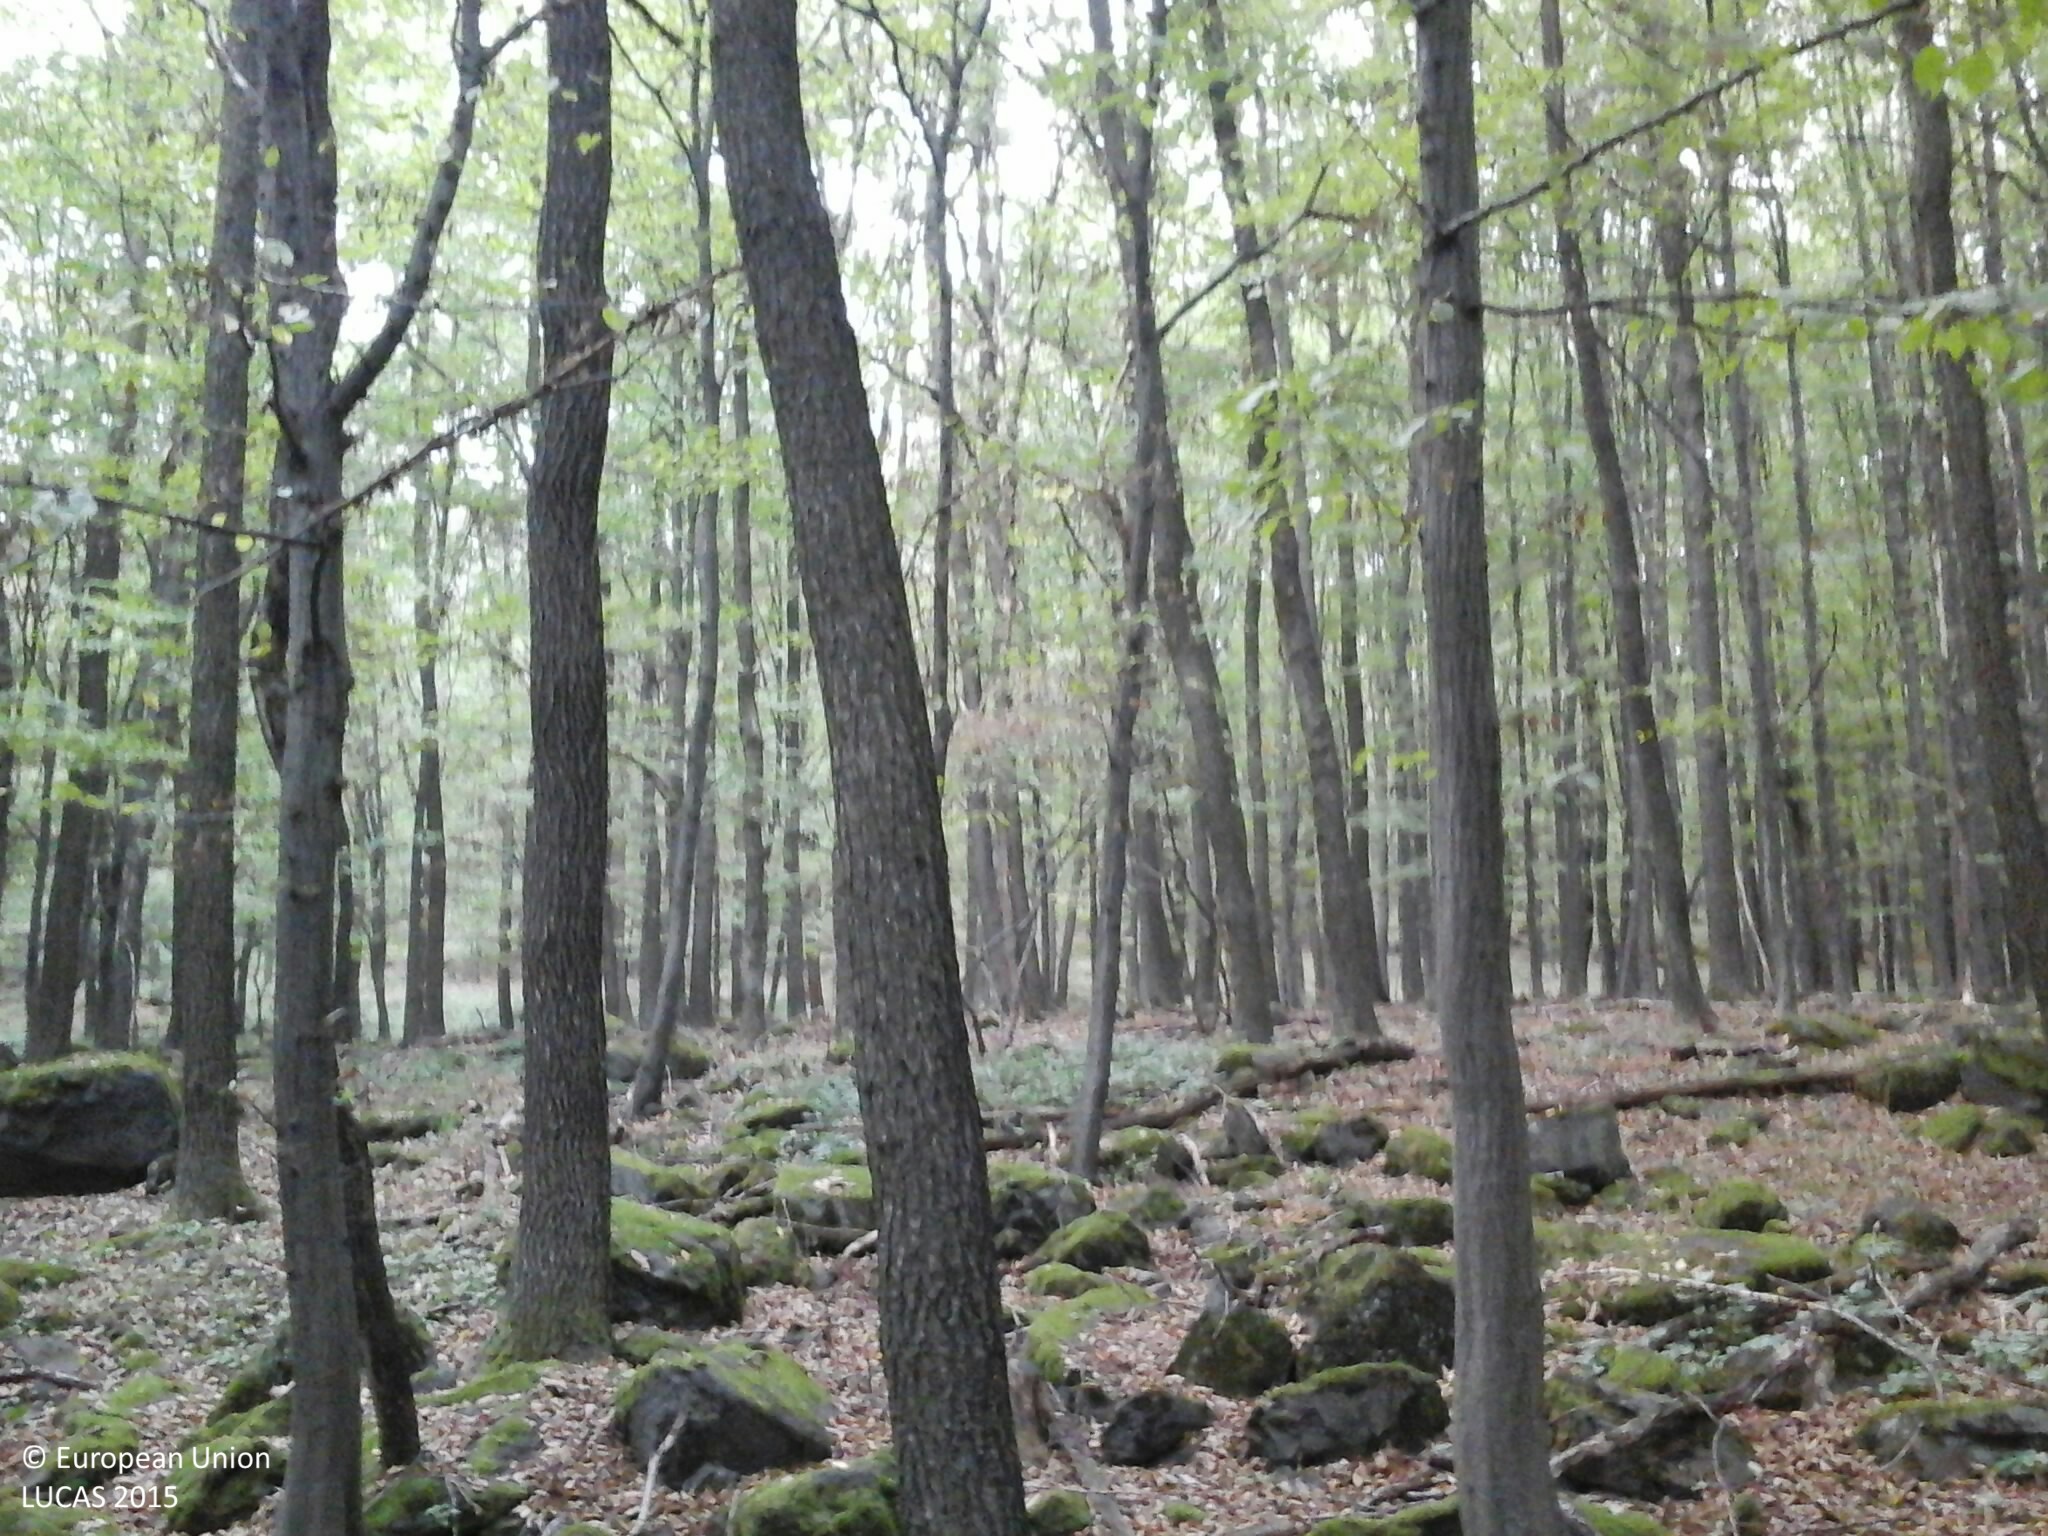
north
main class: Woodland
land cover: Broadleaved woodland
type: mesophytic deciduous forest
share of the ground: > 75 %
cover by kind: broadleaved forest trees 95 %, herbaceous plants 5 %
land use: Forestry
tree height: > 5 m
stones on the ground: 10 - 25 %
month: September
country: HU
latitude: 47.8597
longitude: 19.9853
